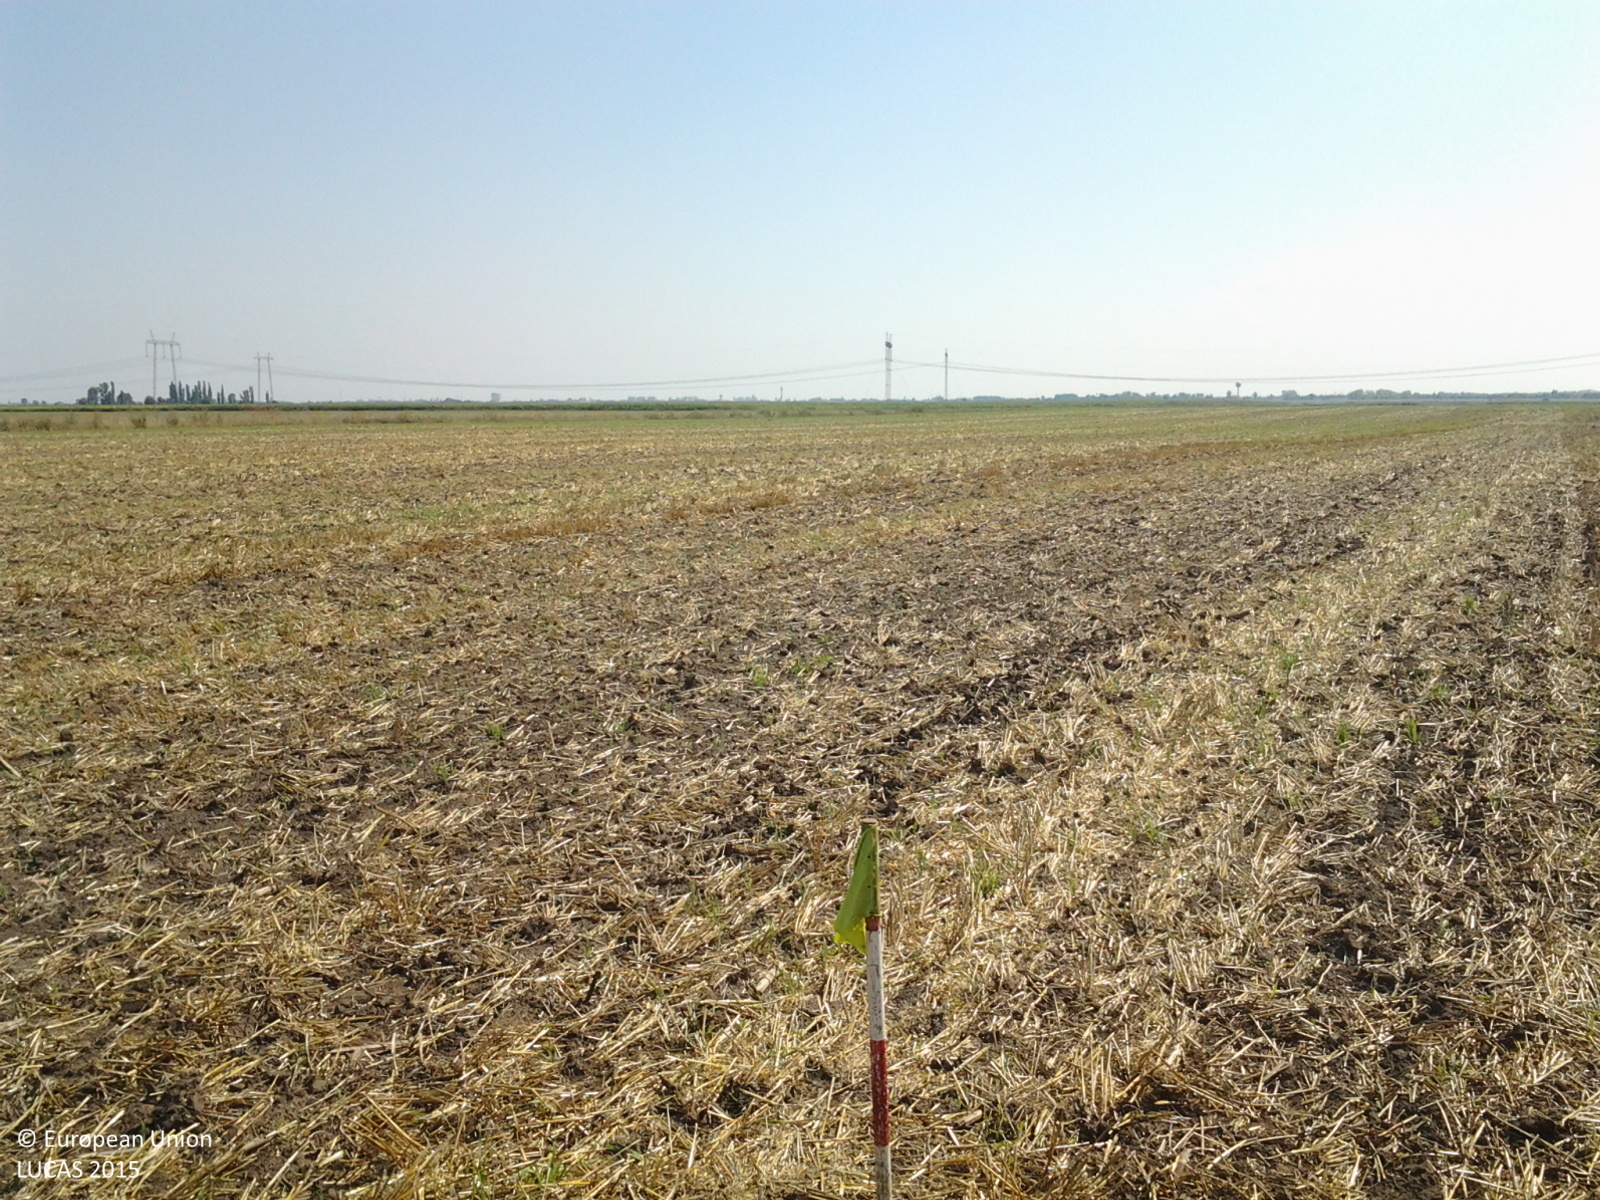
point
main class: Cropland
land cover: Barley
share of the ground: 10 - 25 %
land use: Agriculture (excluding fallow land and kitchen gardens)
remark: Harvested field
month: August
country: HU
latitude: 47.2434
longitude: 19.7860
